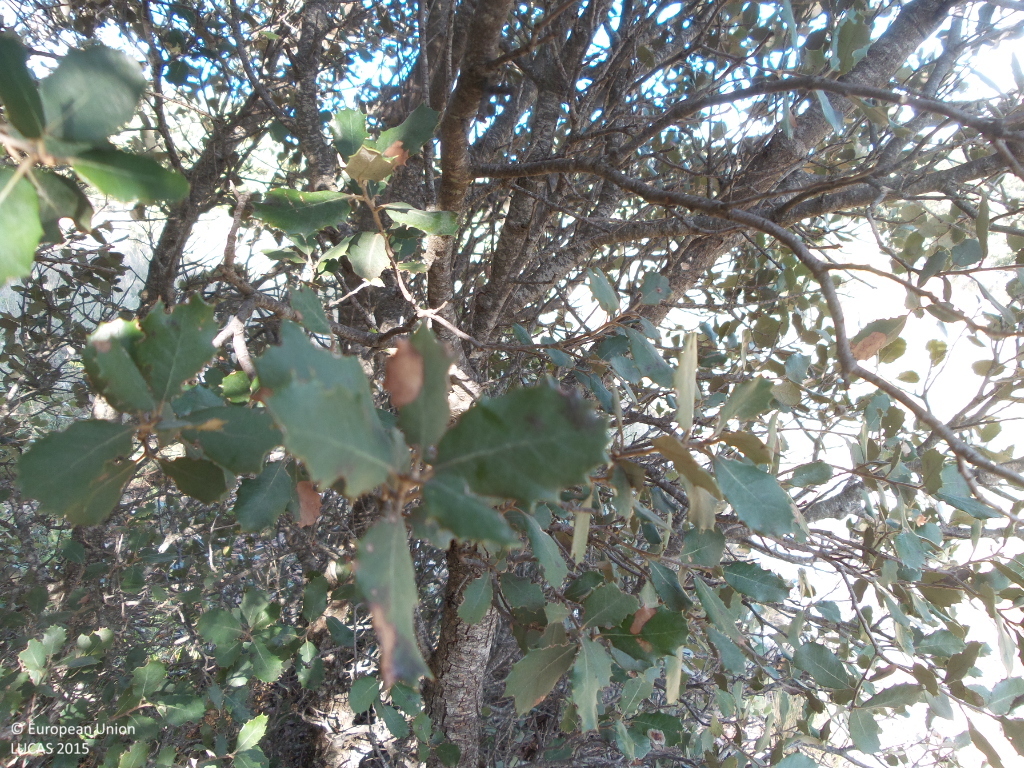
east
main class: Woodland
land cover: Broadleaved woodland
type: broadleaved evergreen forest
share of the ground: 50 - 75 %
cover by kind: broadleaved forest trees 50 %, shrubs 30 %, herbaceous plants 10 %, unconsolidated bare surface 10 %
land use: Semi-natural and natural areas not in use
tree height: < 5 m
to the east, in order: Broadleaved woodland; Tracks; Broadleaved woodland
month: June
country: ES
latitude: 41.3783
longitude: -2.9653
